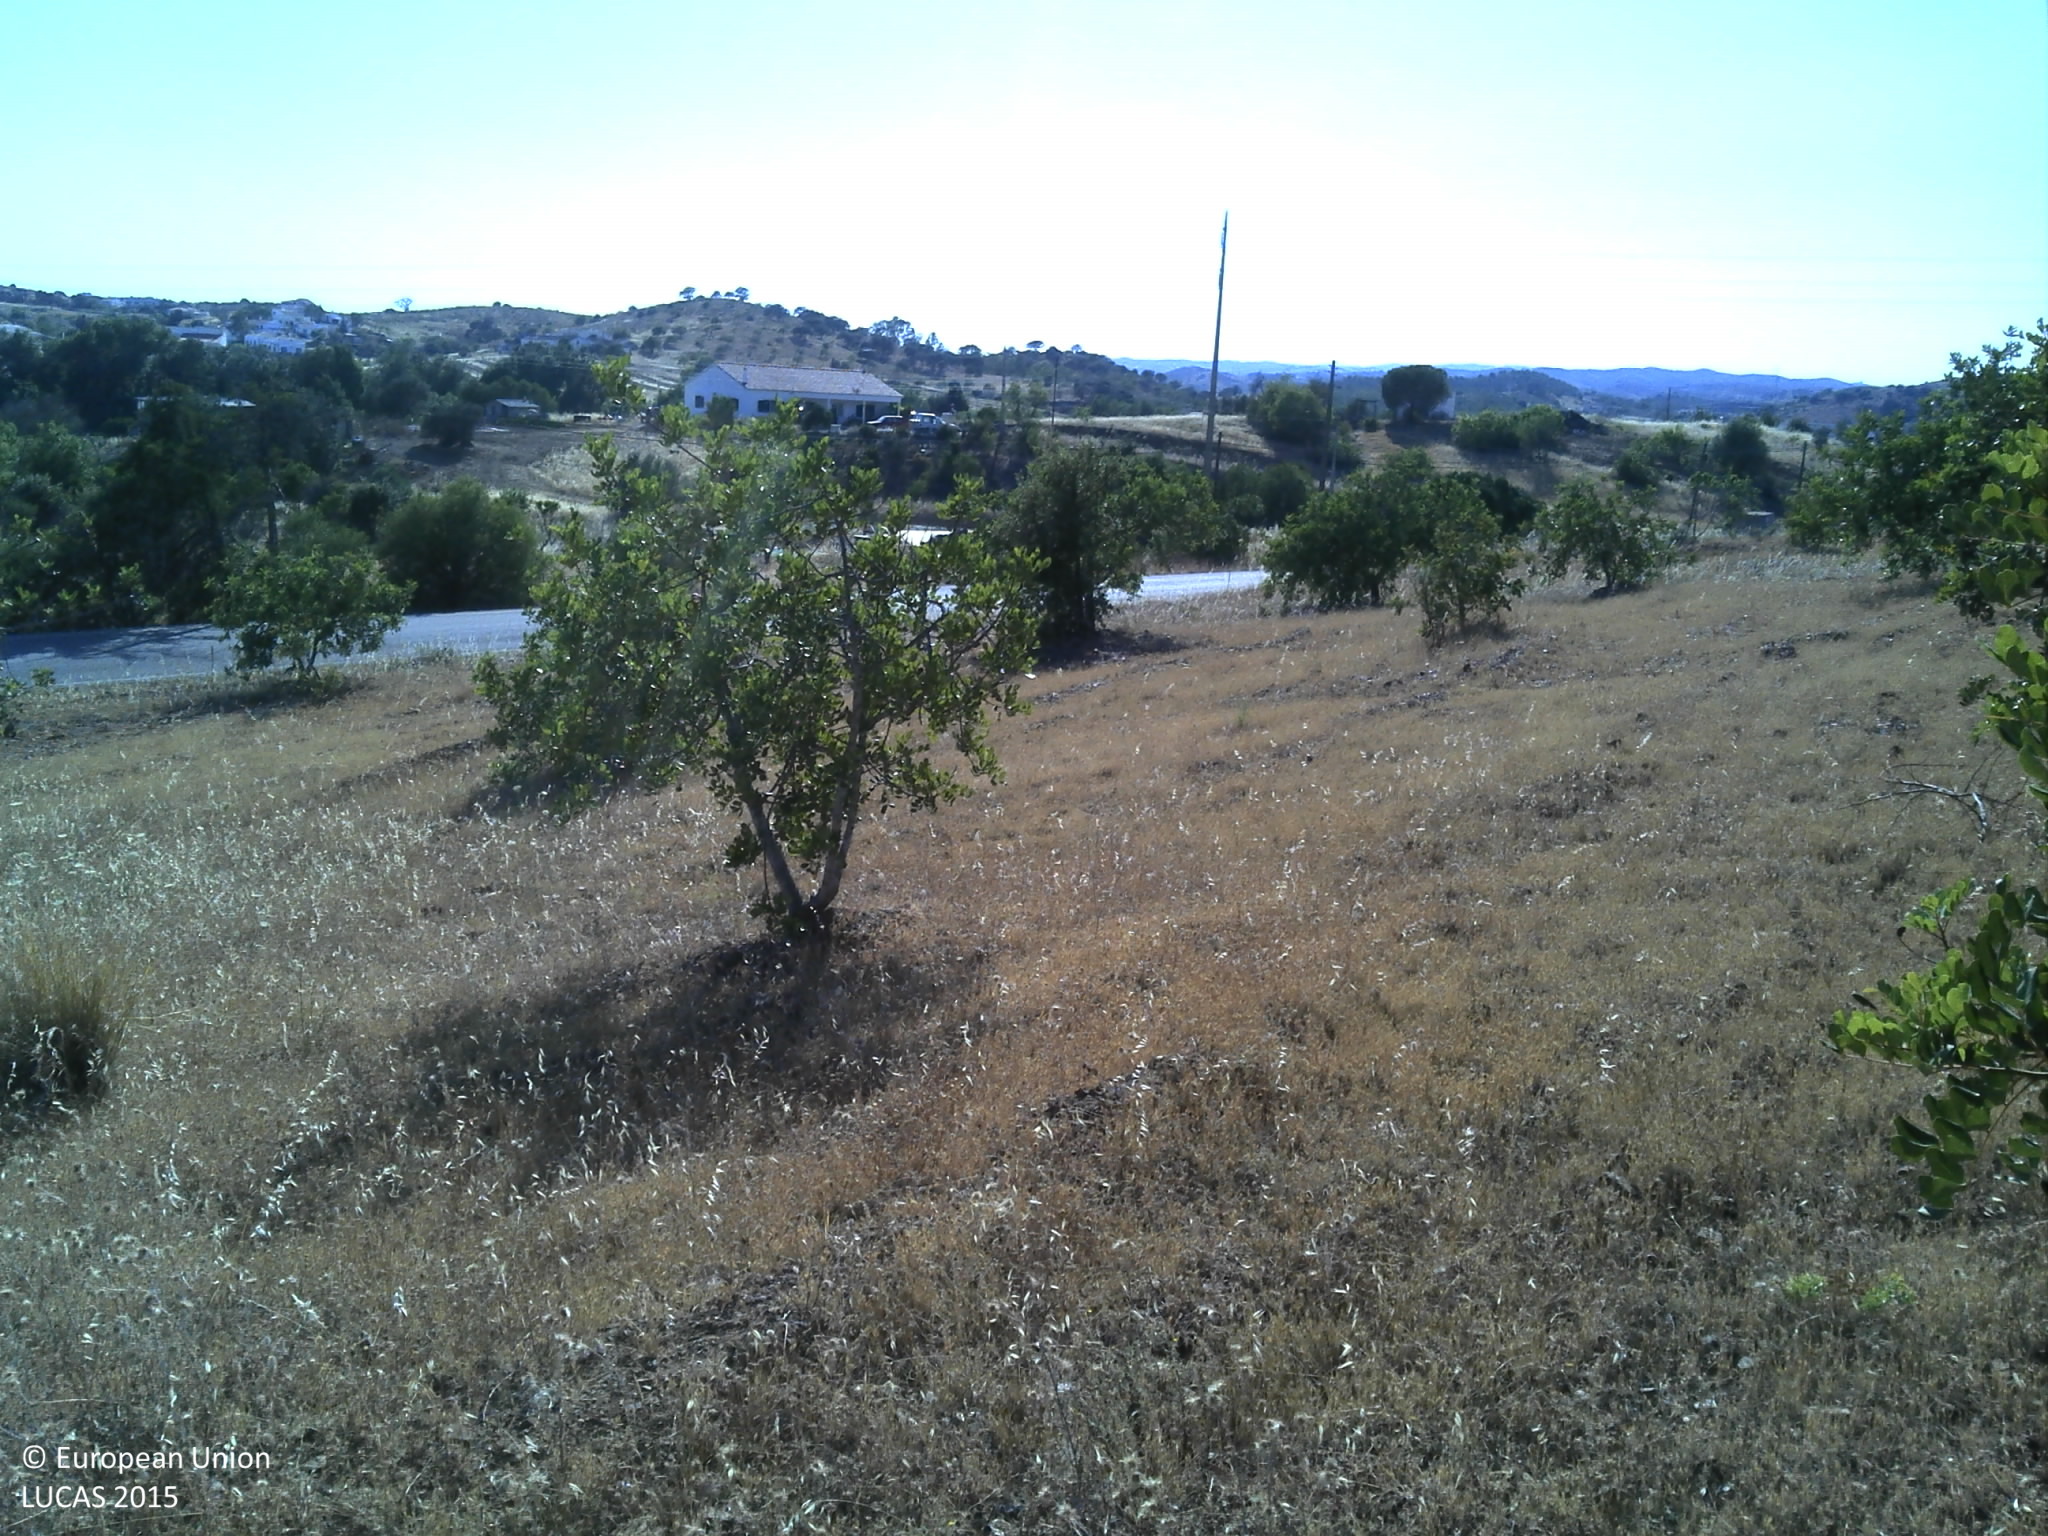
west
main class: Cropland
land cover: Permanent industrial crops
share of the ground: 25 - 50 %
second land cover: Spontaneously vegetated surfaces
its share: > 75 %
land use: Agriculture (excluding fallow land and kitchen gardens)
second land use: Other primary production
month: May
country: PT
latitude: 37.2240
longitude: -7.4833
